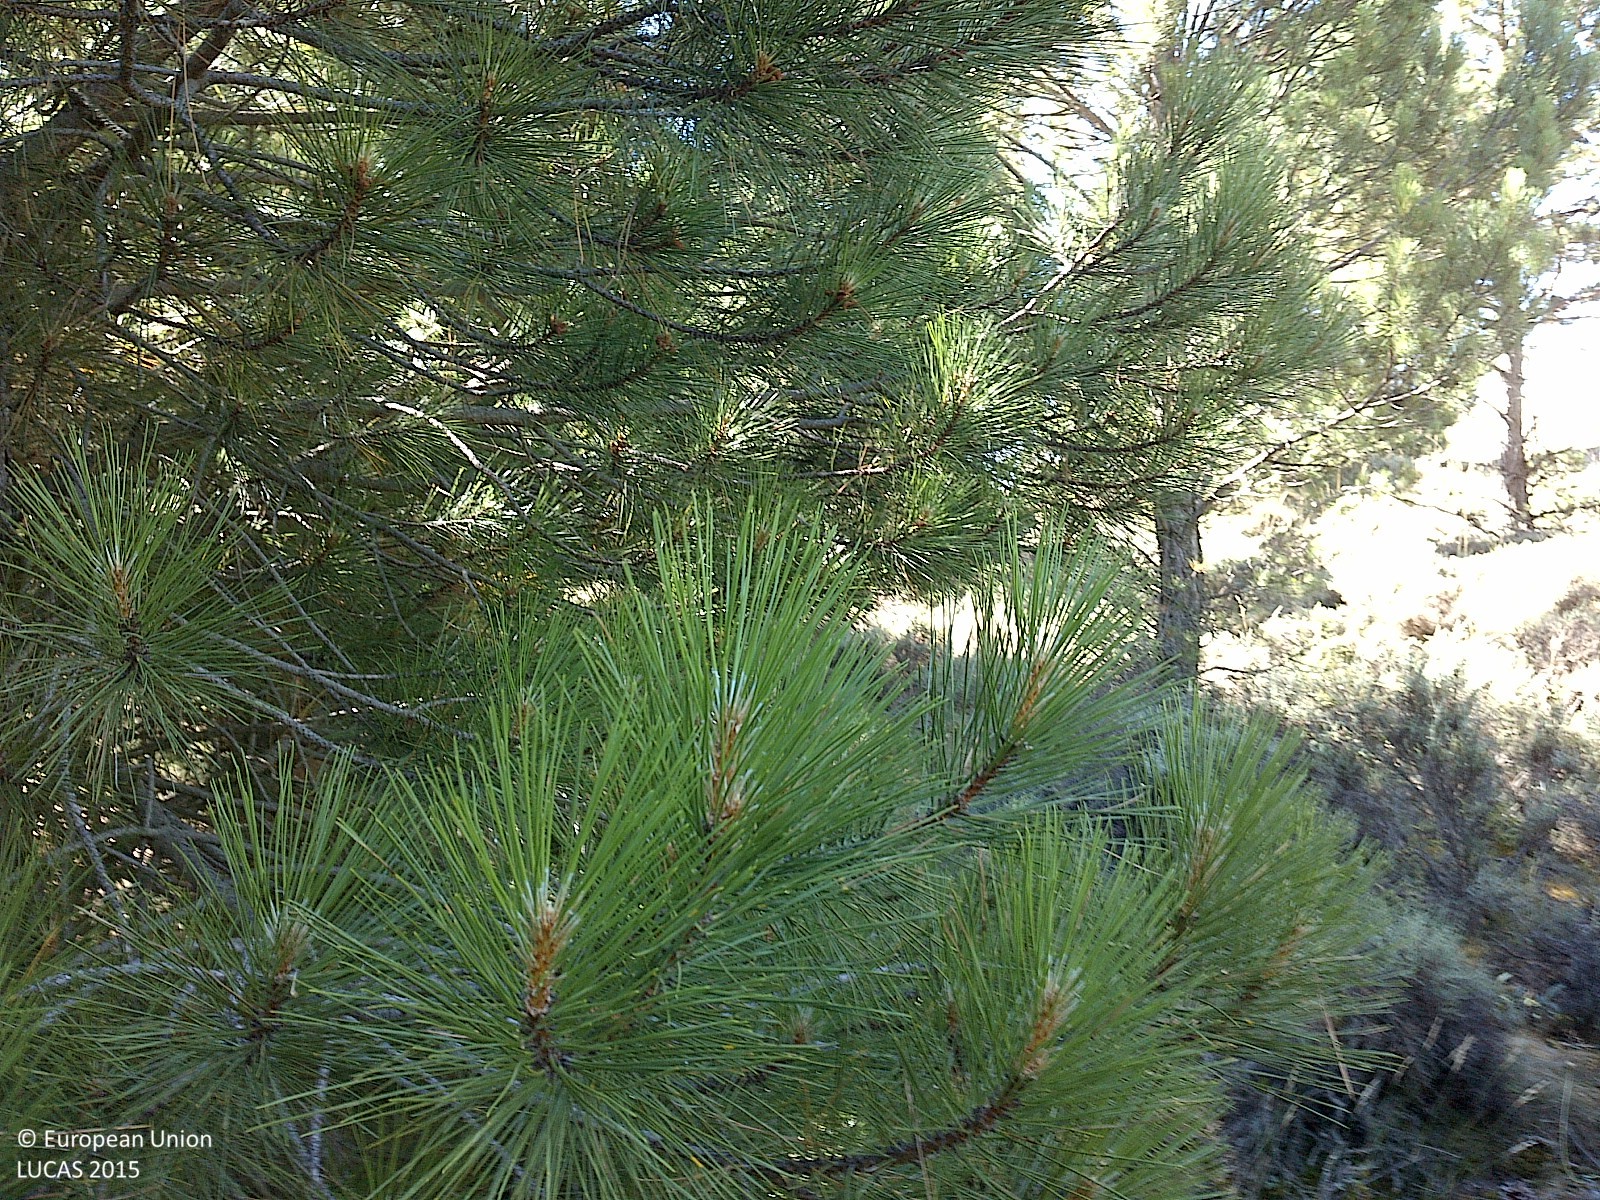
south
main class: Woodland
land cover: Pine dominated coniferous woodland
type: coniferous forest of the mediterranean region
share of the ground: 25 - 50 %
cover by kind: shrubs 55 %, coniferous forest trees 35 %, herbaceous plants 10 %
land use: Forestry
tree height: < 5 m
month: July
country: ES
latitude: 41.9668
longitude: -2.2123
